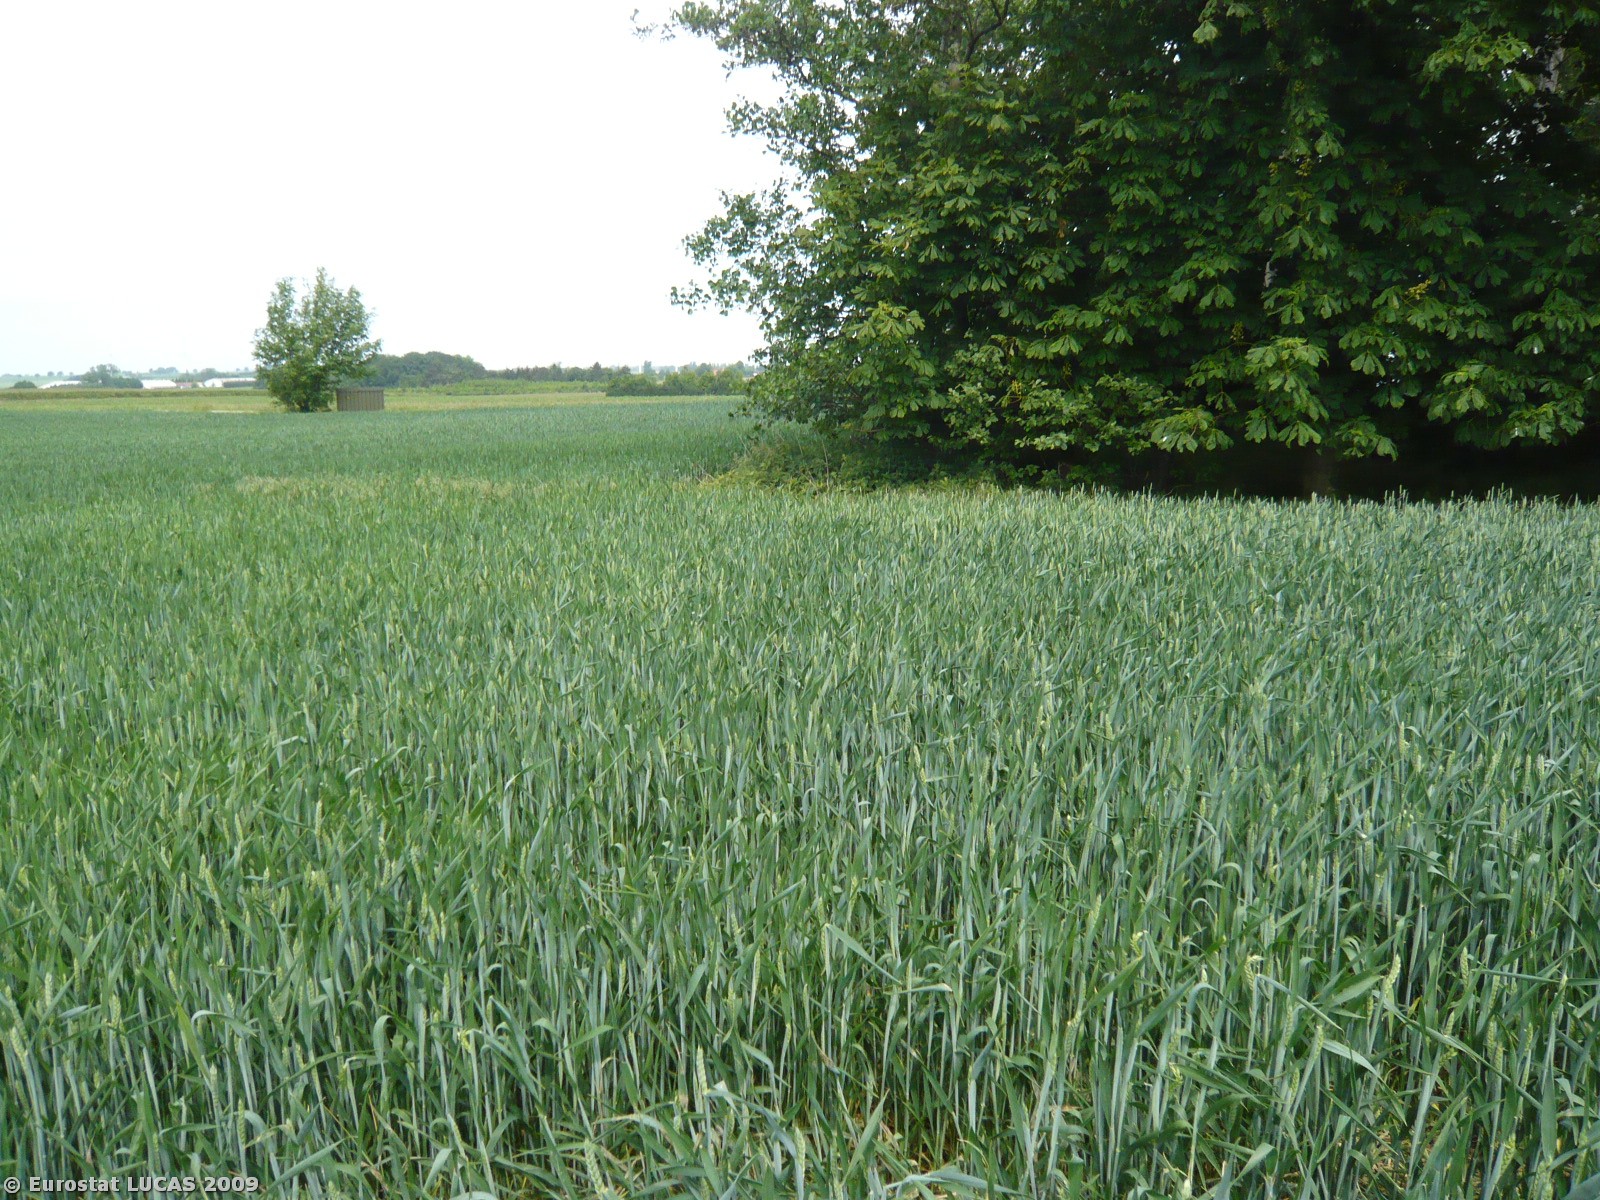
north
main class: Cropland
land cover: Common wheat
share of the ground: > 75 %
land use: Agriculture (excluding fallow land and kitchen gardens)
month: June
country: DK
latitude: 55.2816
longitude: 11.3686
